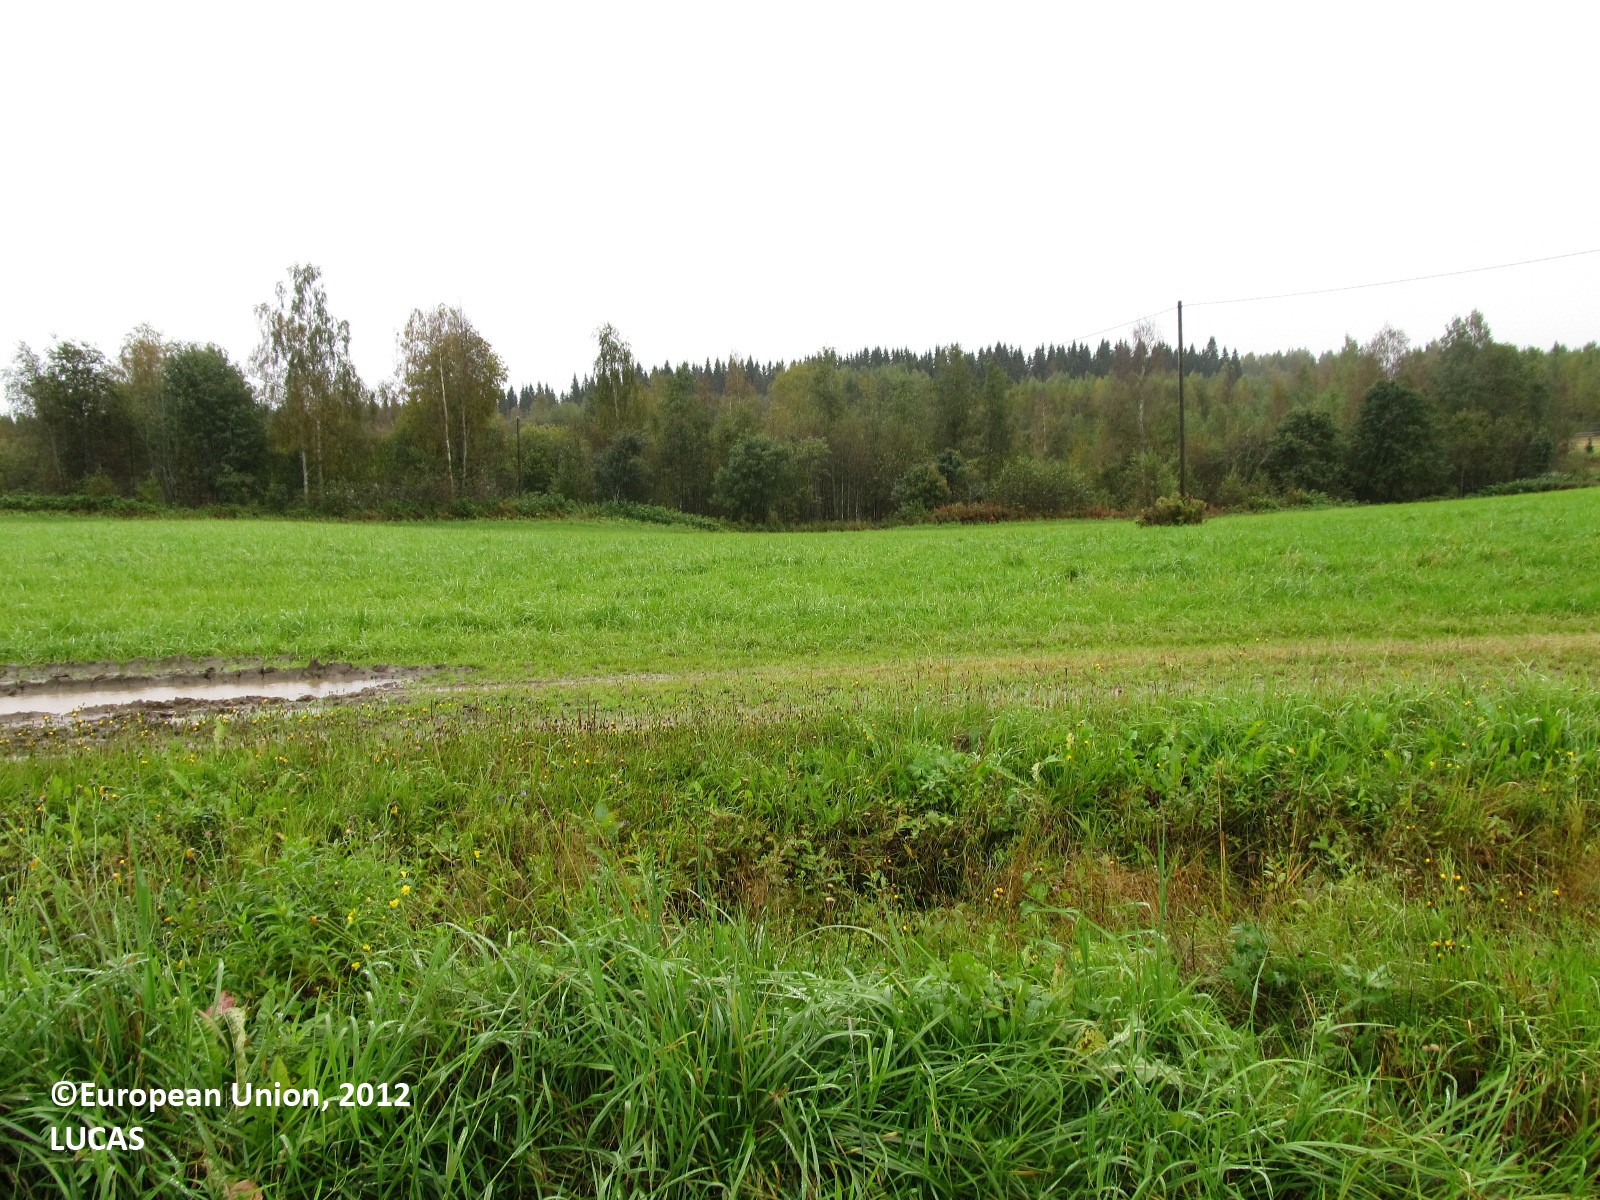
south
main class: Cropland
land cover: Temporary grasslands
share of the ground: > 75 %
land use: Agriculture (excluding fallow land and kitchen gardens)
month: September
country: FI
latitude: 63.1477
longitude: 28.0165
